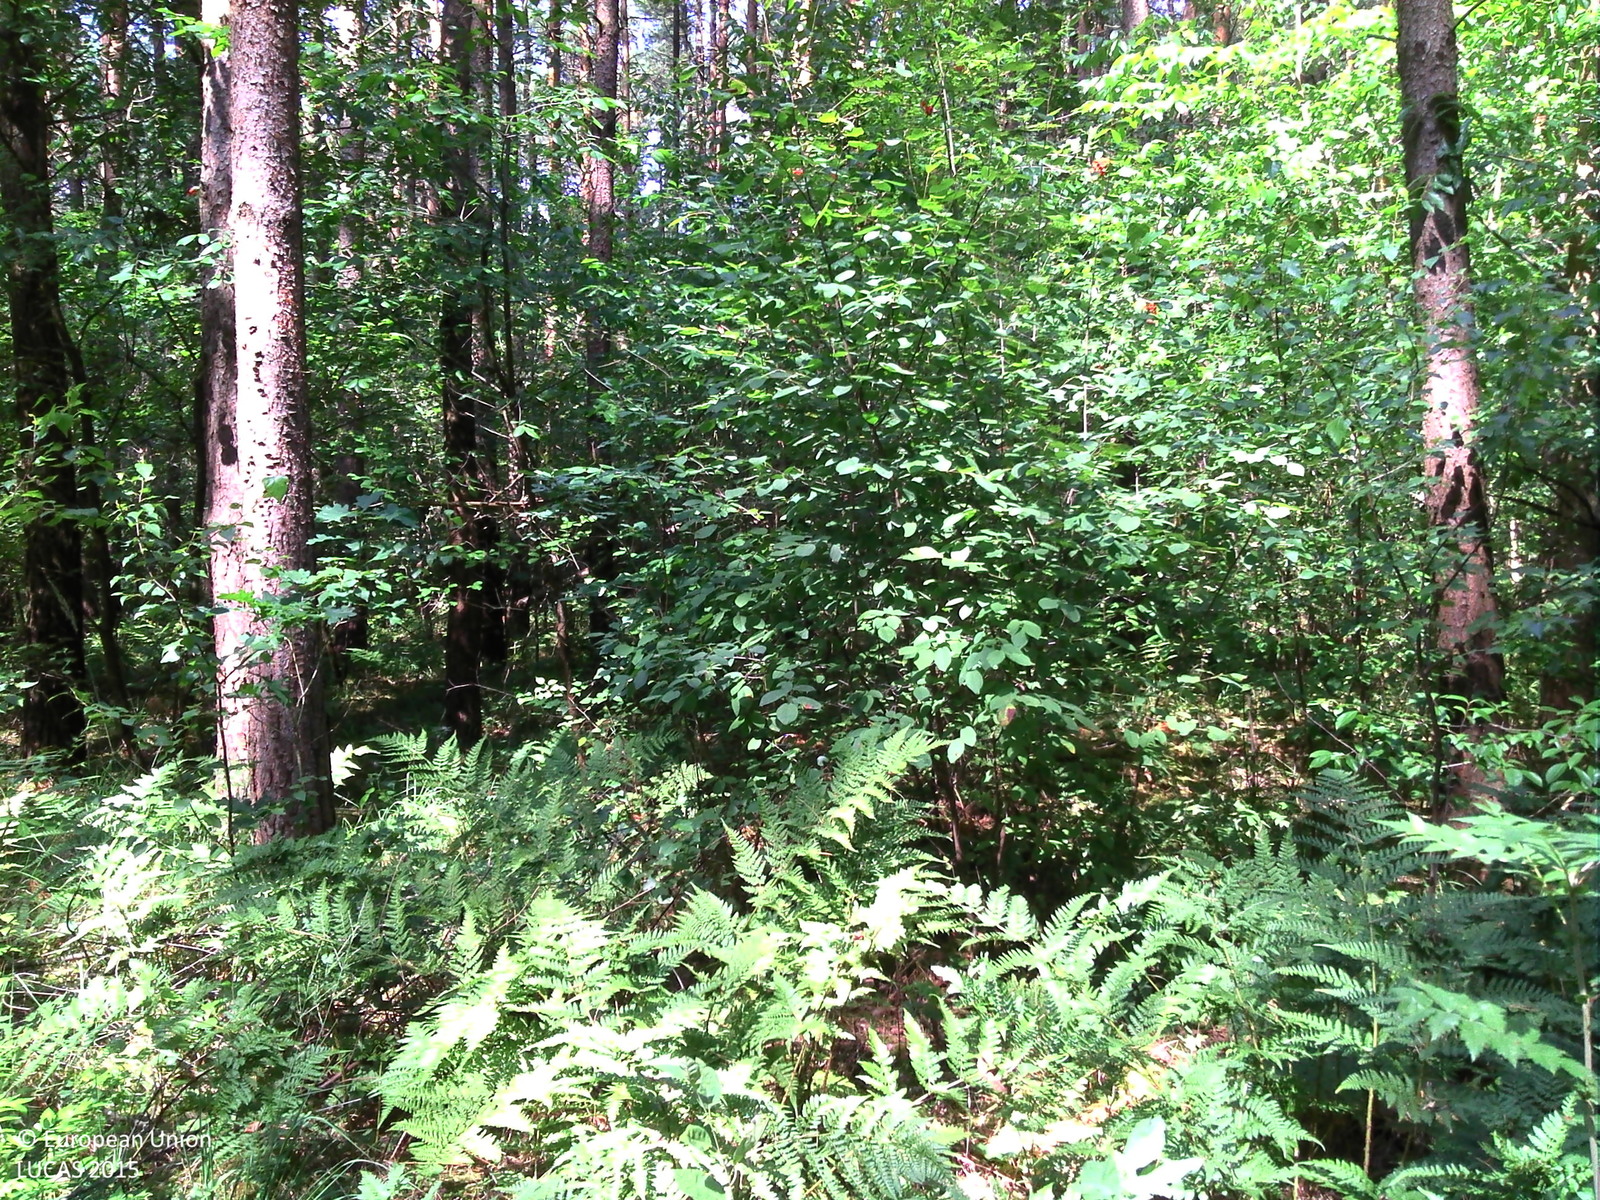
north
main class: Woodland
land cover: Pine dominated mixed woodland
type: exotic forest
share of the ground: > 75 %
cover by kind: coniferous forest trees 70 %, broadleaved forest trees 30 %
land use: Forestry
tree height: > 5 m
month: August
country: BE
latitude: 51.2126
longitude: 5.5175
